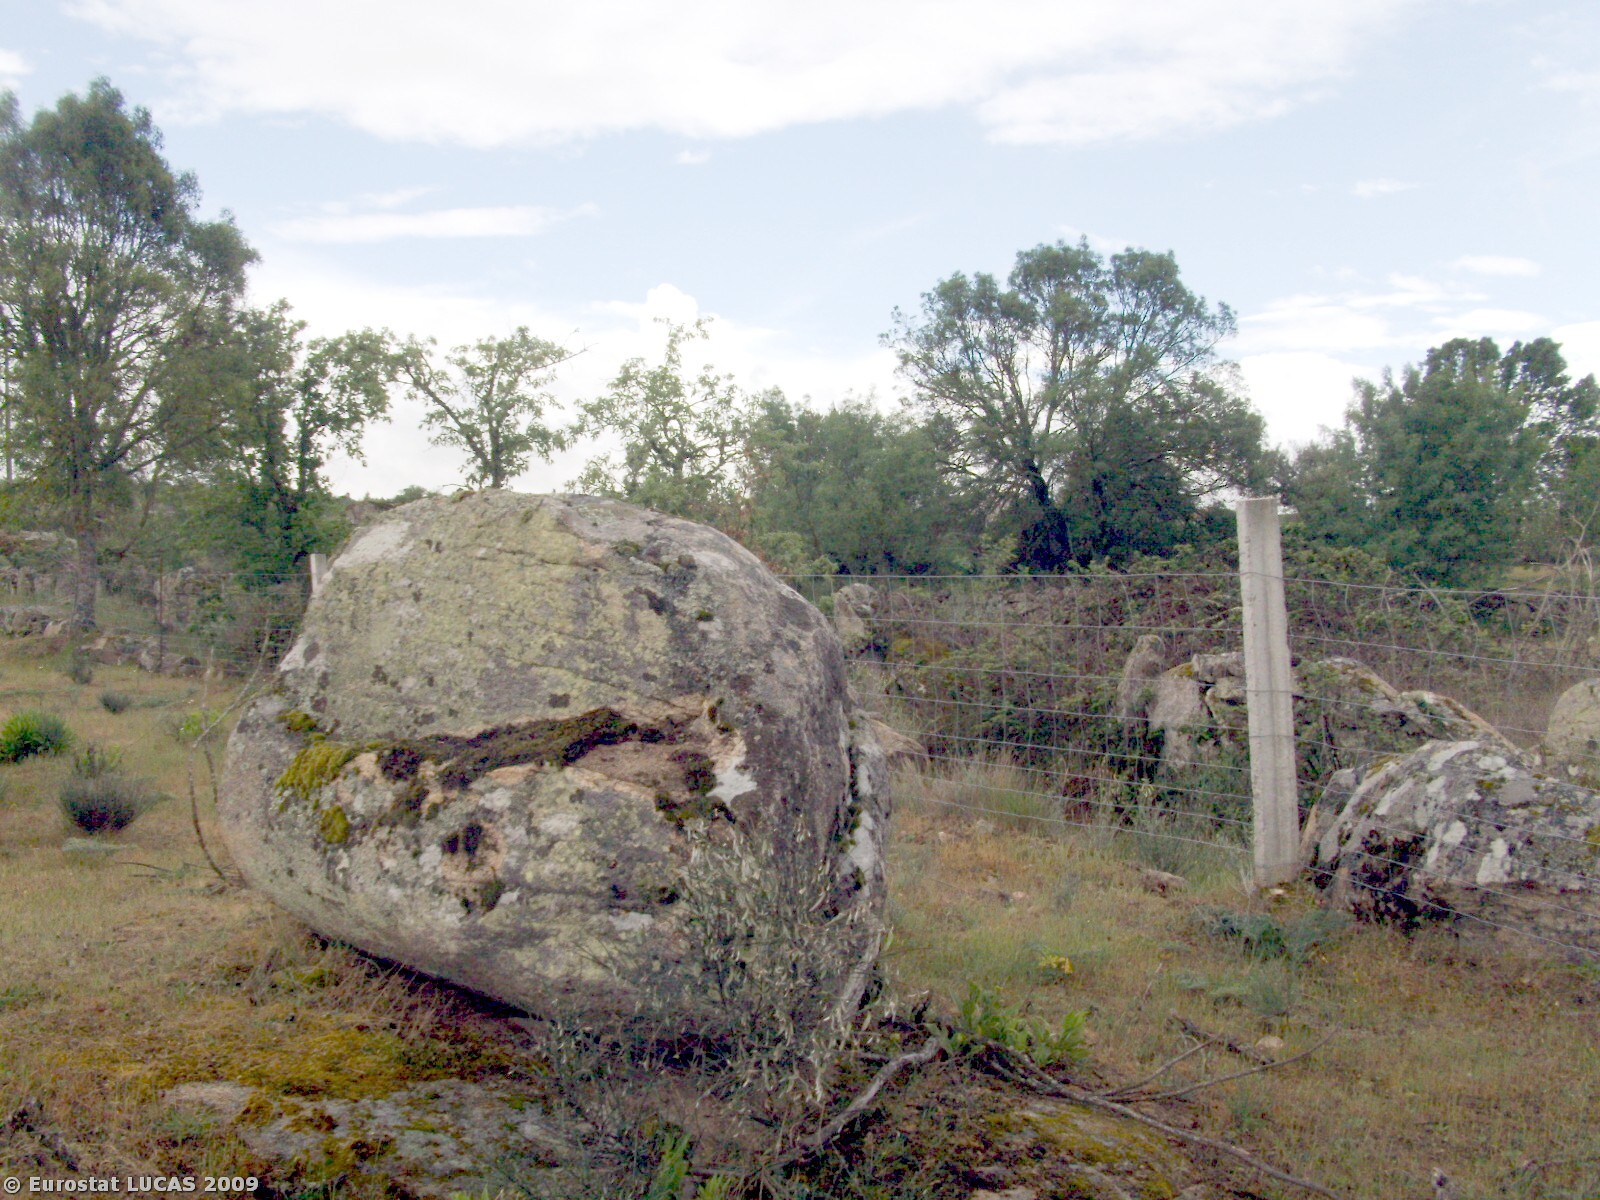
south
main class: Grassland
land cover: Spontaneously vegetated surfaces
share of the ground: > 75 %
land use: Fallow land
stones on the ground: 25 - 50 %
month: May
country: PT
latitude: 40.6881
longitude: -7.1083
